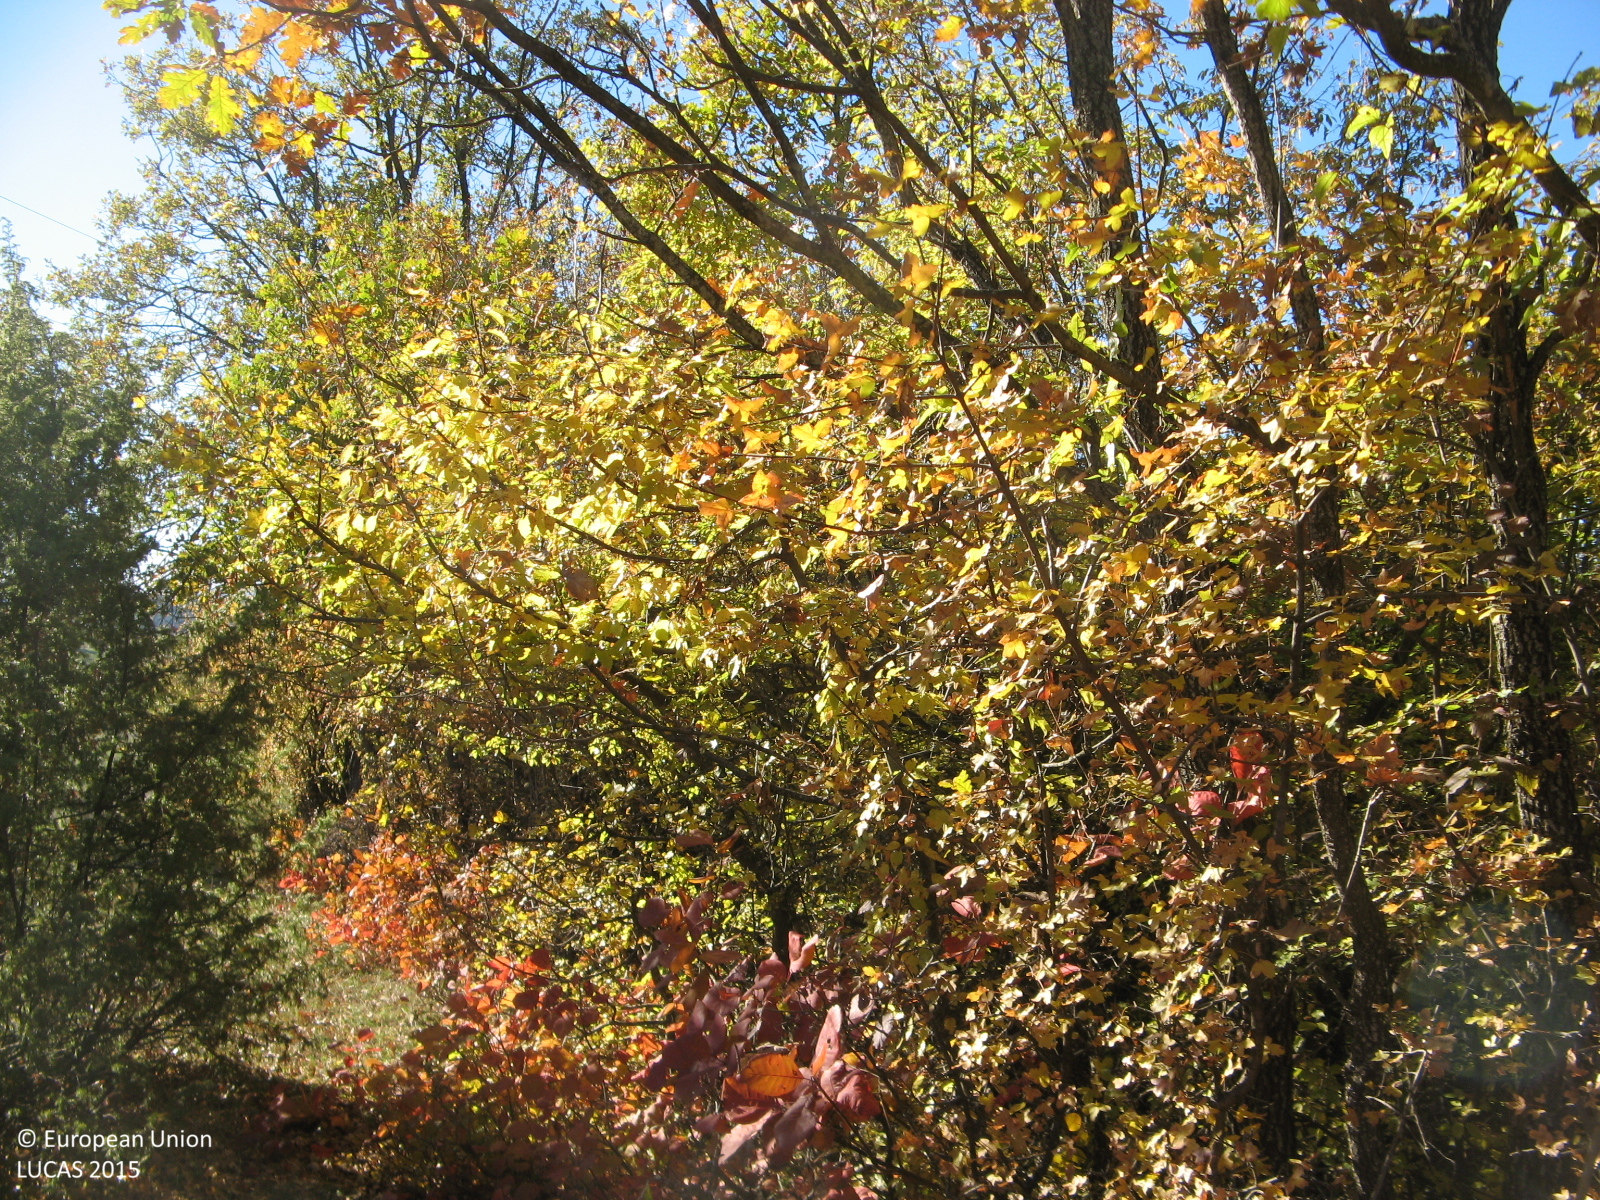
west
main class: Woodland
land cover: Broadleaved woodland
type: thermophilous deciduous forest
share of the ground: > 75 %
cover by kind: broadleaved forest trees 95 %, herbaceous plants 5 %
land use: Forestry
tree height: > 5 m
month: November
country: BG
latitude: 41.5403
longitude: 25.2893
